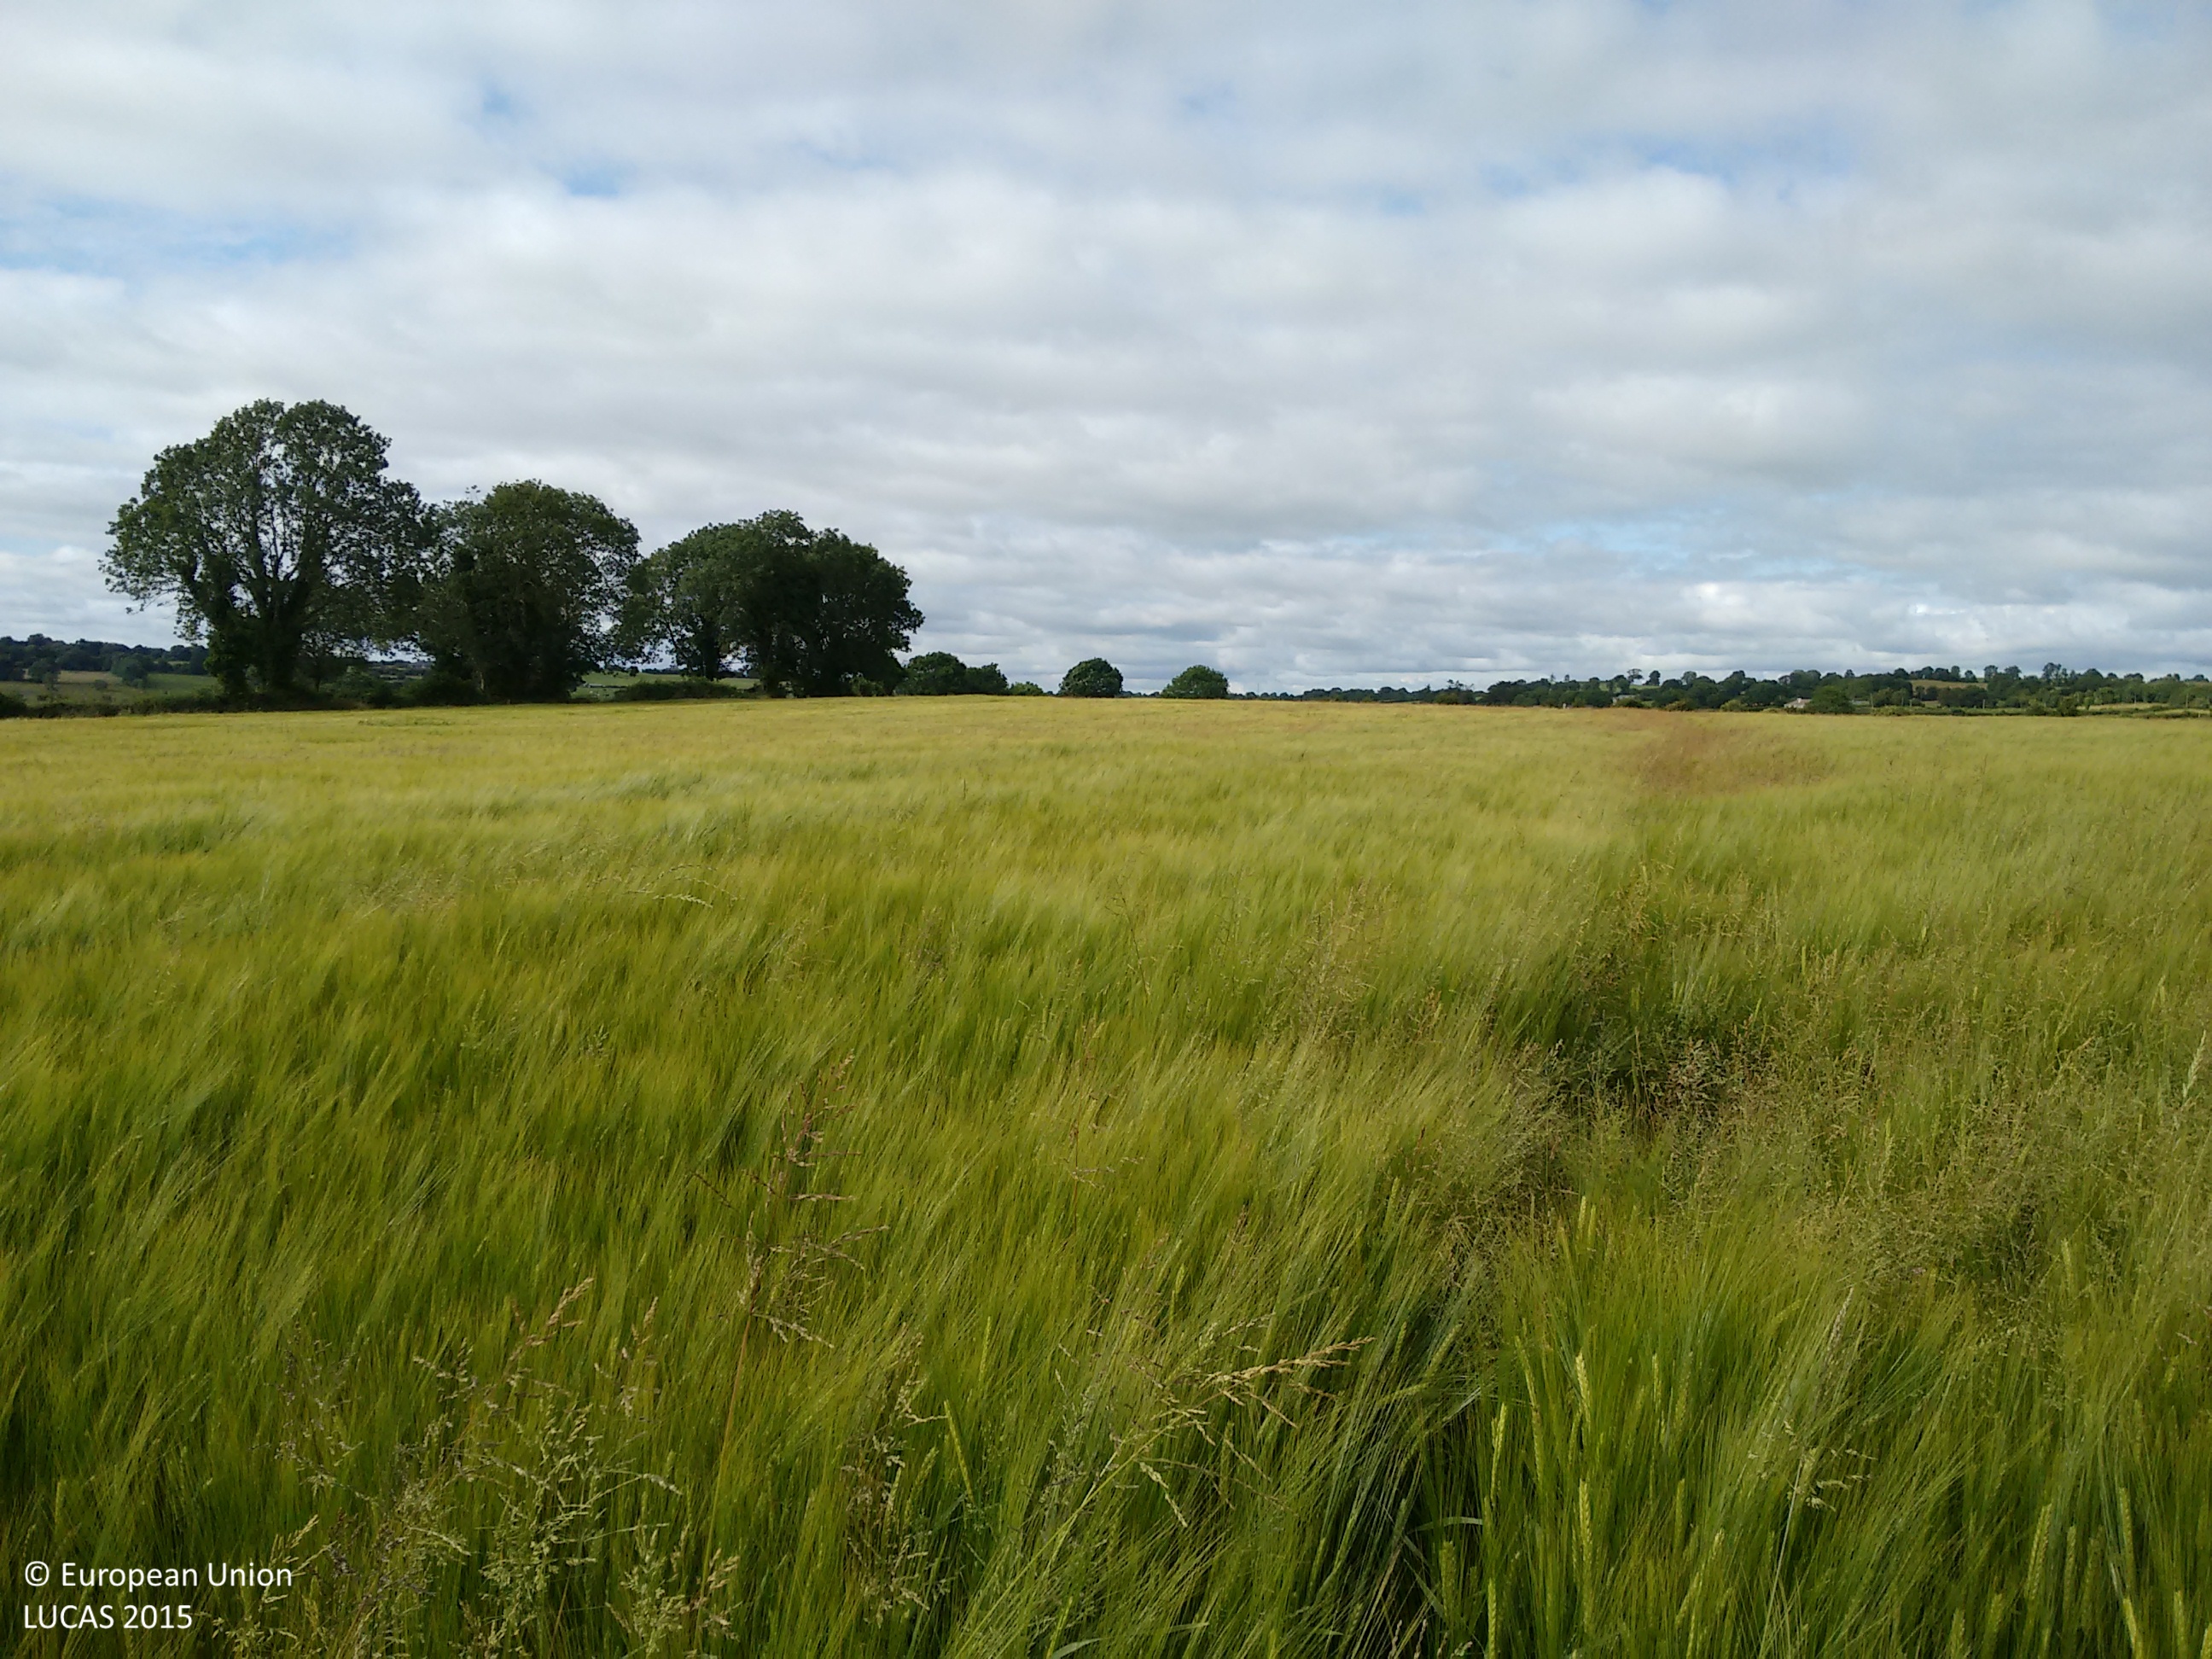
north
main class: Cropland
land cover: Barley
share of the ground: > 75 %
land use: Agriculture (excluding fallow land and kitchen gardens)
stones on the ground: < 10 %
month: July
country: IE
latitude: 53.4677
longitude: -7.8084
